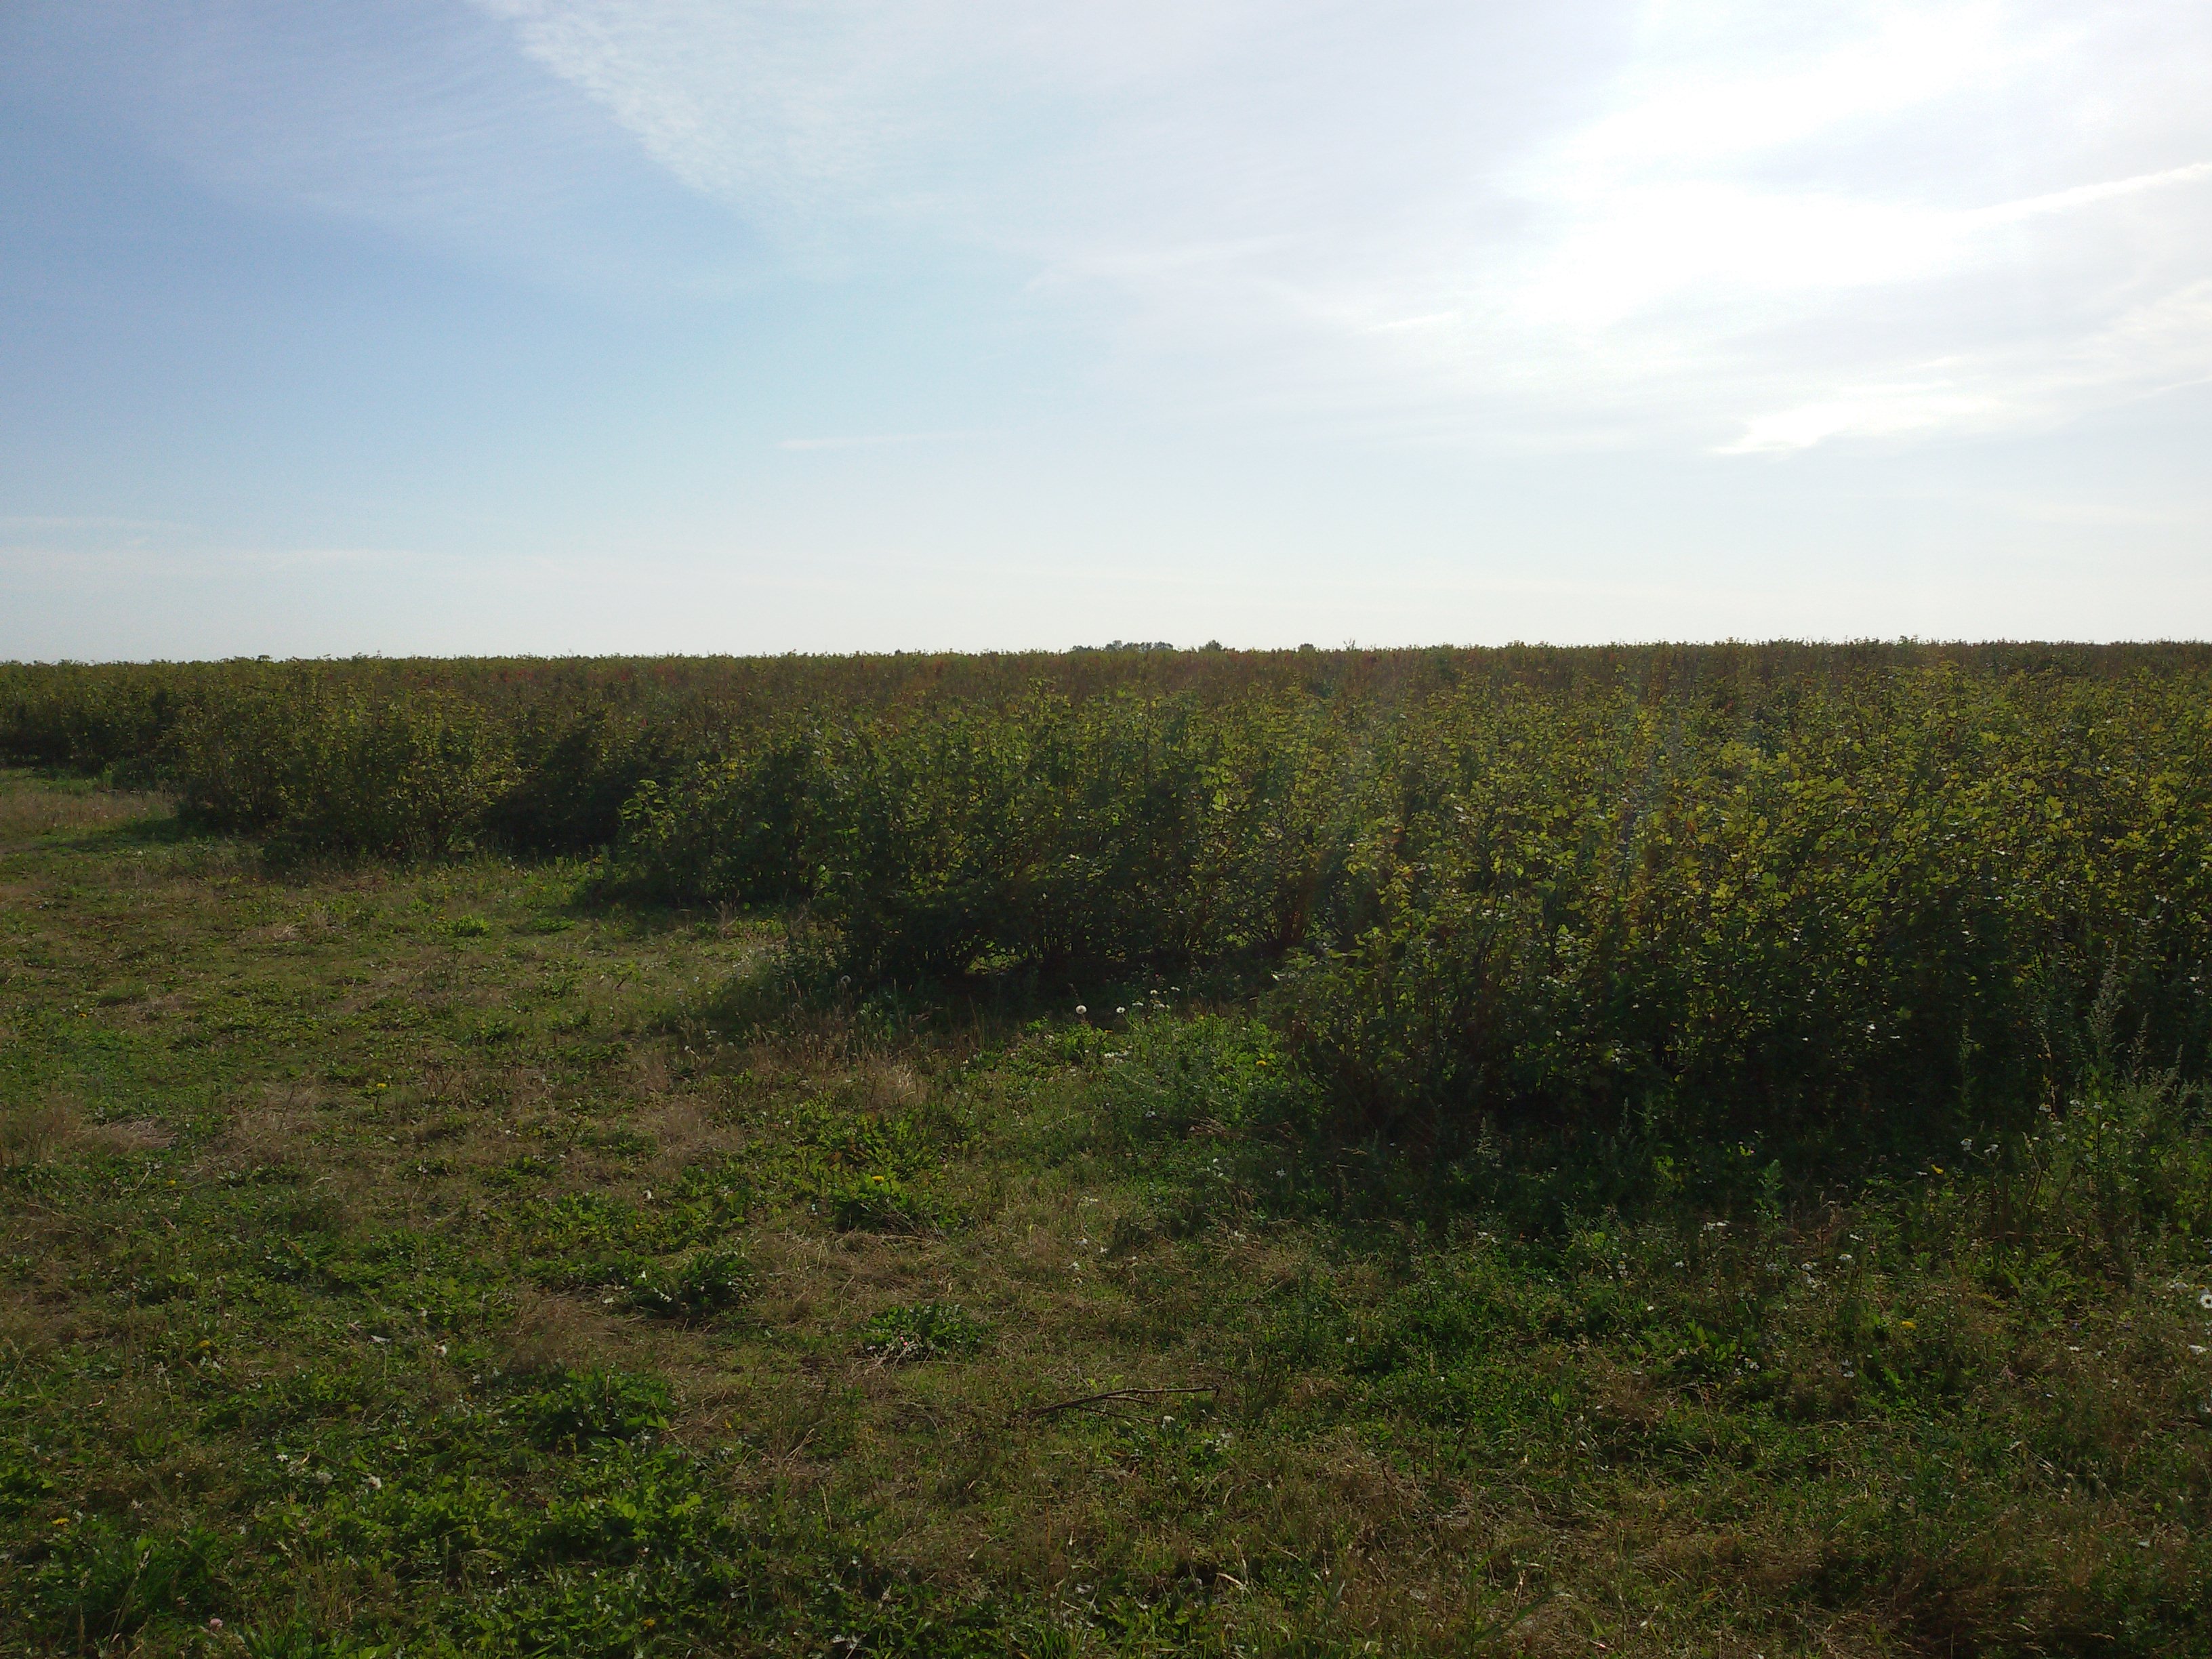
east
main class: Cropland
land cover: Oats
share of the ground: > 75 %
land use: Agriculture (excluding fallow land and kitchen gardens)
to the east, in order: Oats; Tracks; Other fruit trees and berries; Spontaneously vegetated surfaces; Tracks
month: August
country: PL
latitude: 53.6069
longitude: 17.1281
